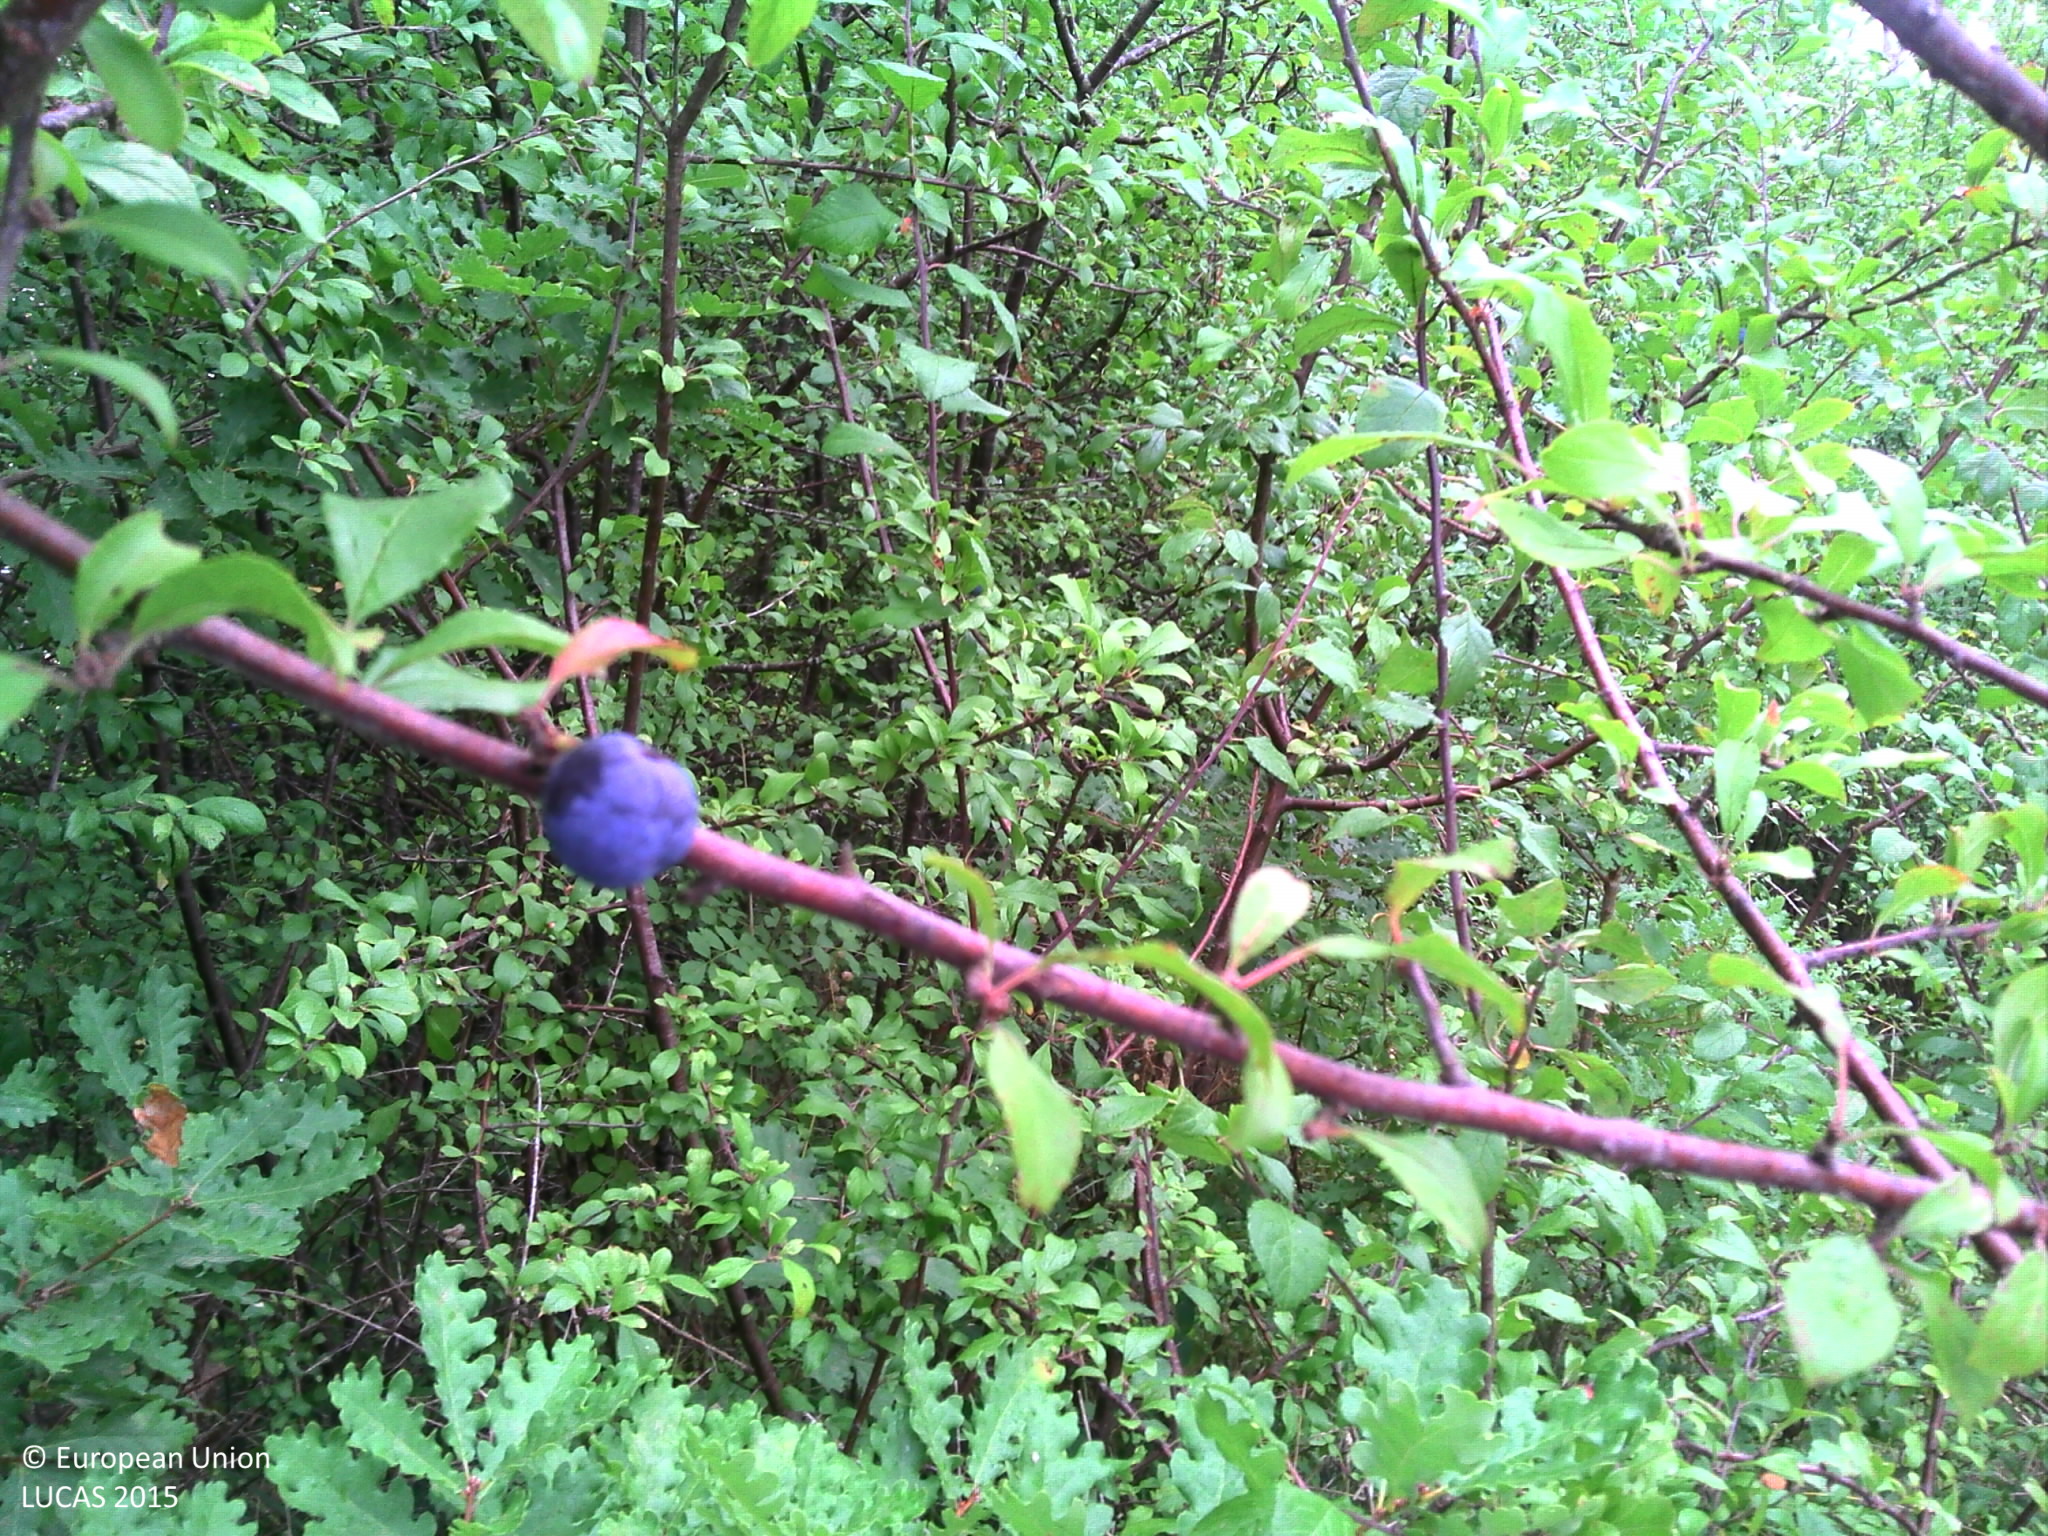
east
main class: Woodland
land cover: Broadleaved woodland
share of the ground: > 75 %
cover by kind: broadleaved forest trees 60 %, shrubs 35 %, herbaceous plants 5 %
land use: Semi-natural and natural areas not in use
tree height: < 5 m
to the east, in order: Broadleaved woodland; Inland fresh running water; Abandoned hedges; Grass margins; Tracks; Grass margins; Barley; Grass margins; Tracks; Common wheat; Maize
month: July
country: FR
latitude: 44.1280
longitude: 0.8607
